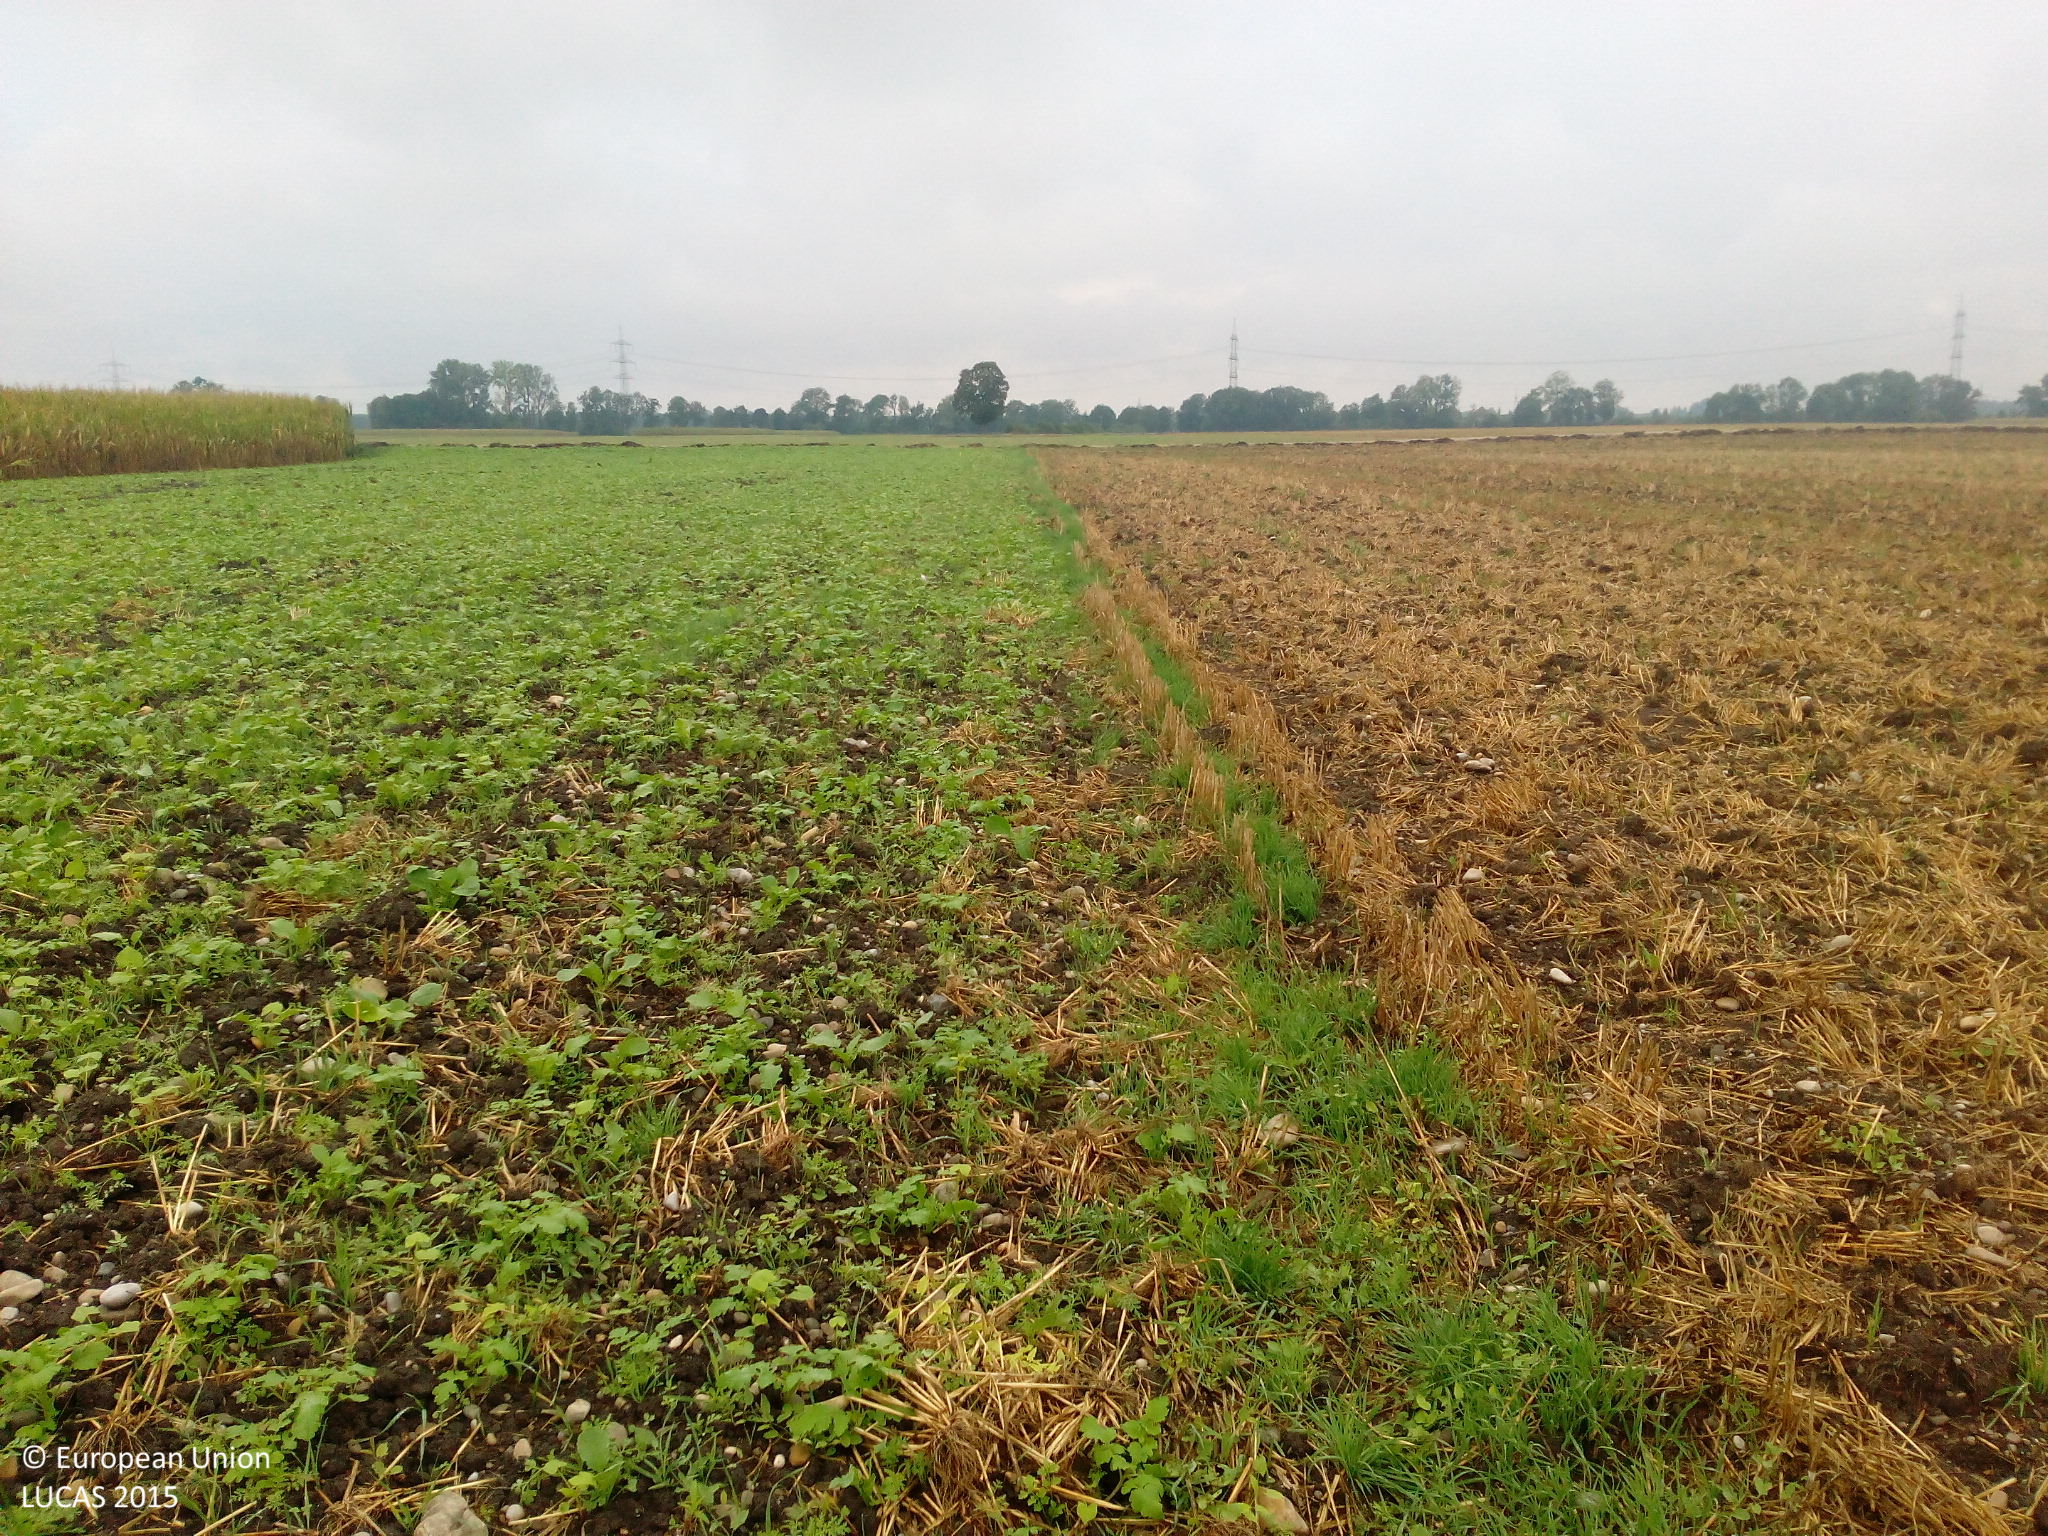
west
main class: Cropland
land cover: Common wheat
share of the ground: < 10 %
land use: Agriculture (excluding fallow land and kitchen gardens)
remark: Harvested field
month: September
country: DE
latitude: 48.2554
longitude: 10.9557
